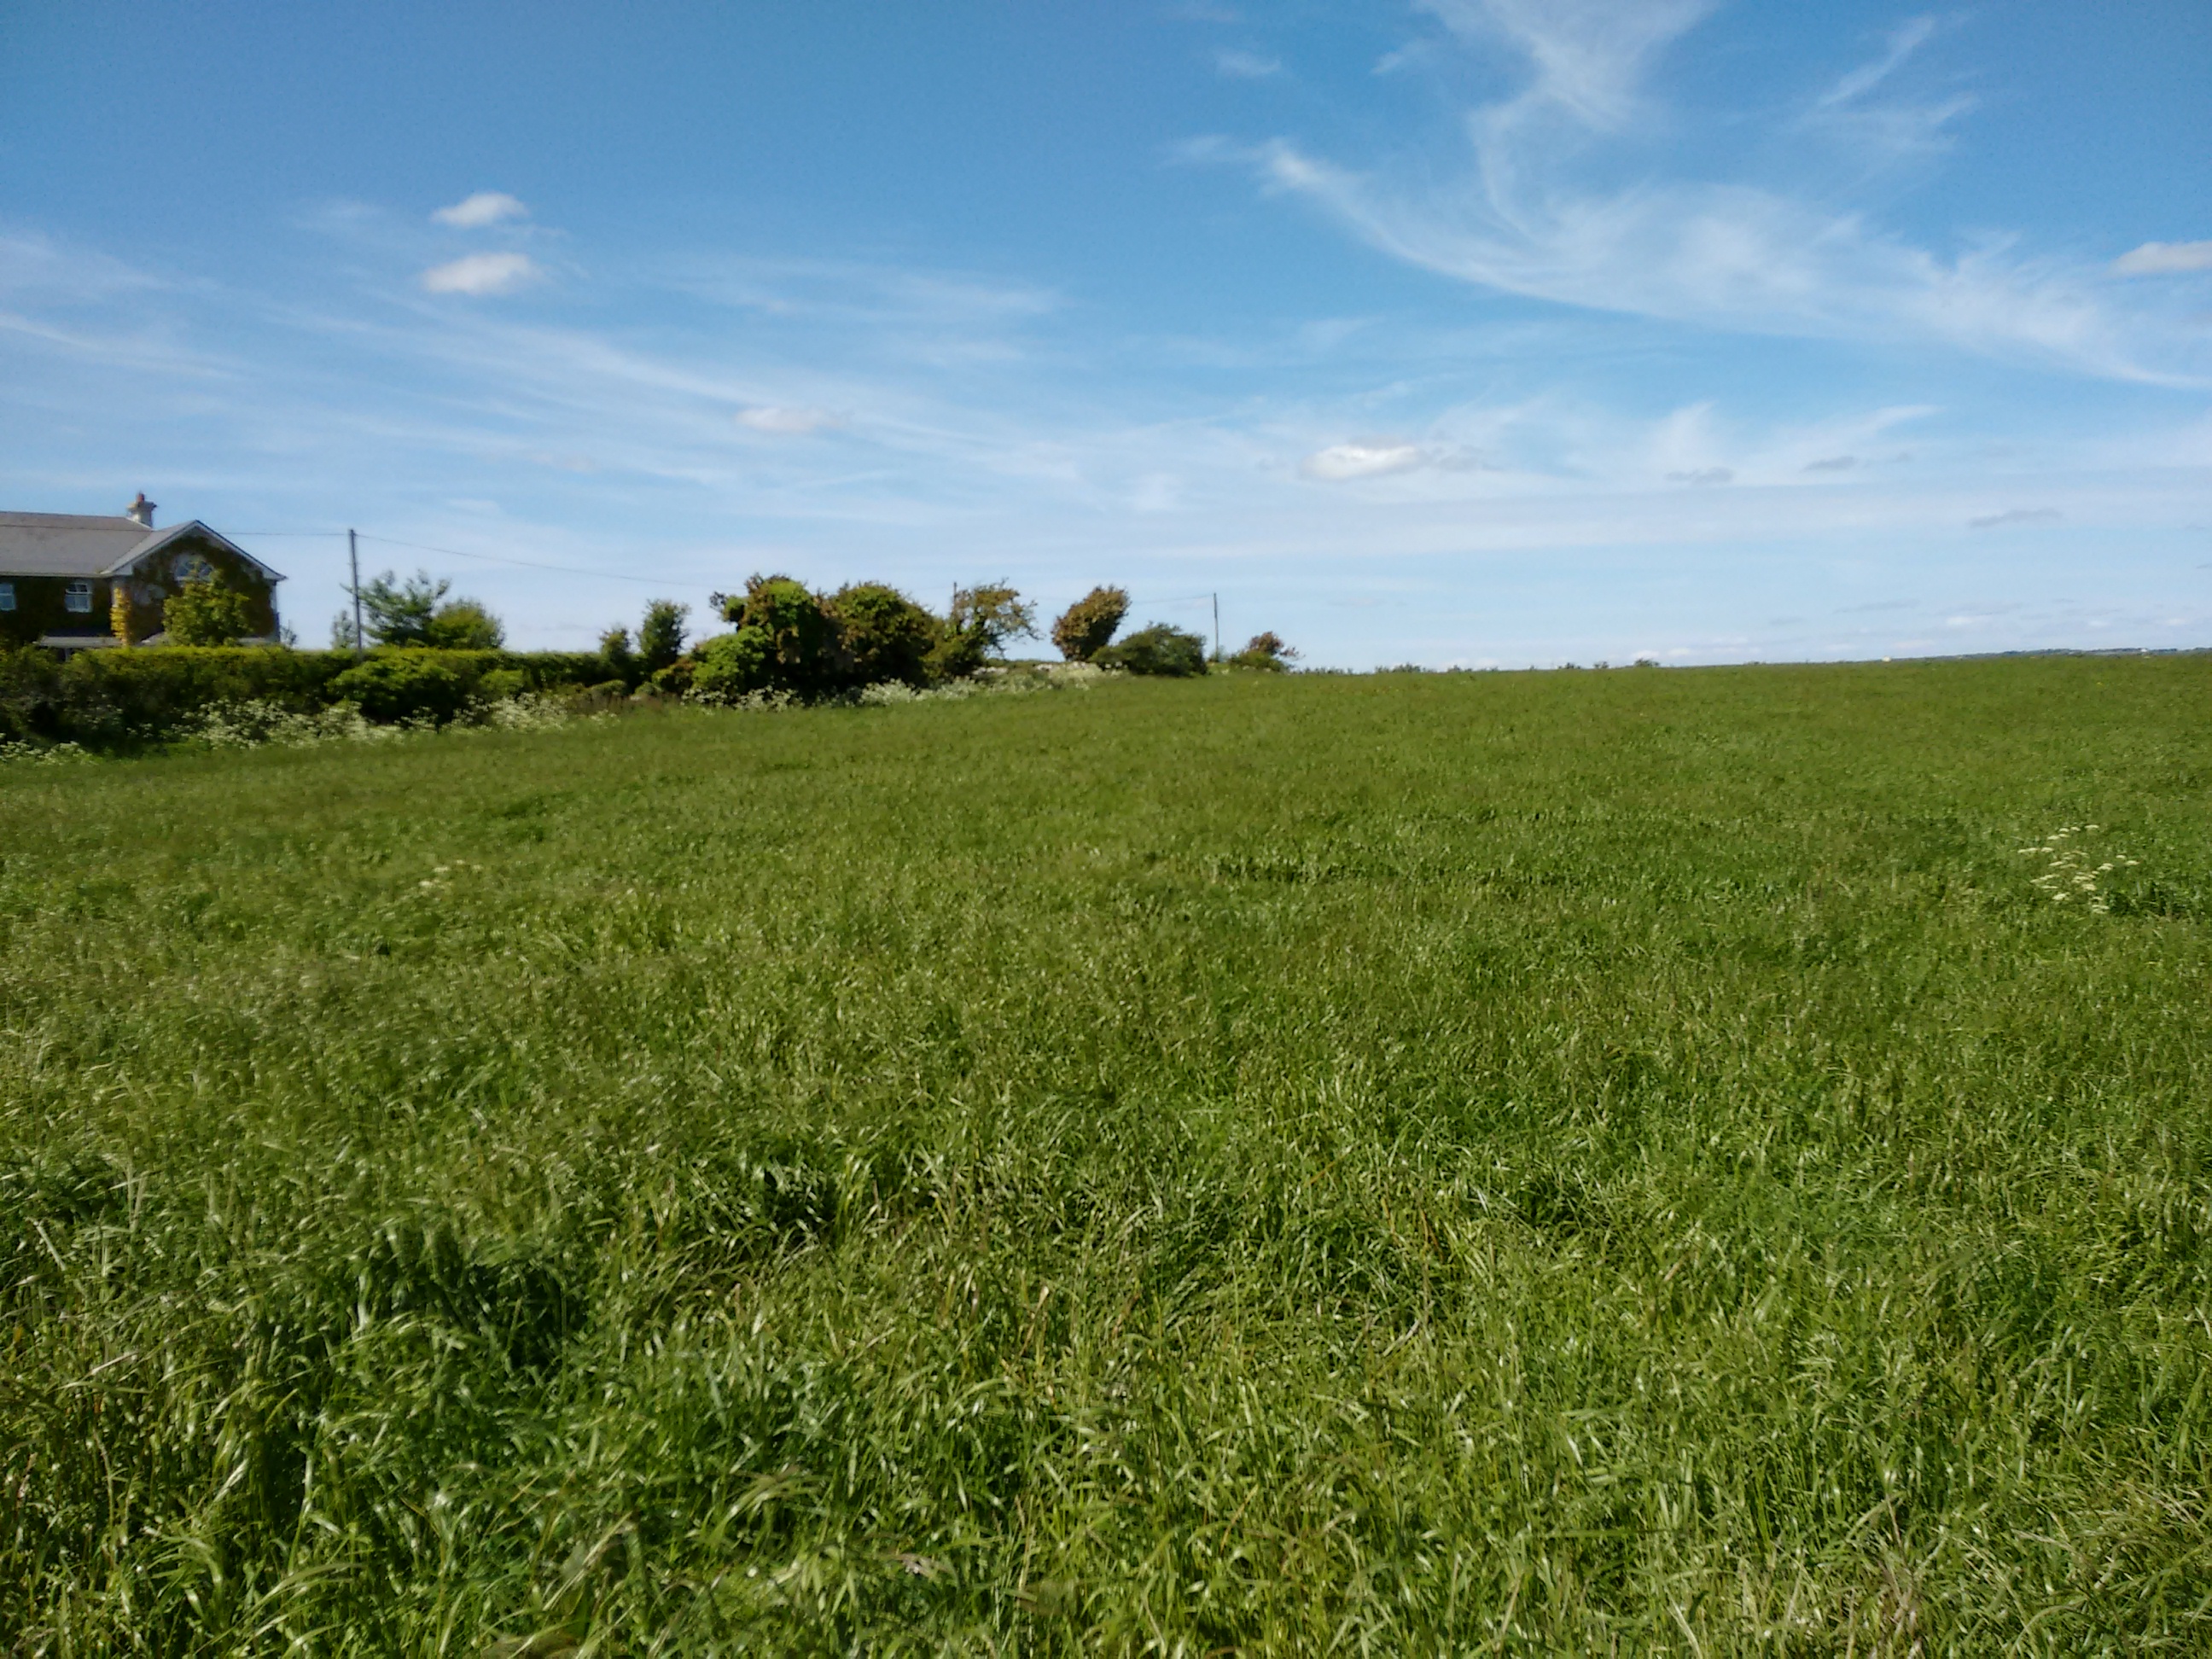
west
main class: Grassland
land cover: Grassland without tree/shrub cover
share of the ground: > 75 %
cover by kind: herbaceous plants 100 %
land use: Agriculture (excluding fallow land and kitchen gardens)
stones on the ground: < 10 %
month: June
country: IE
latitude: 53.2523
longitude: -8.9613
